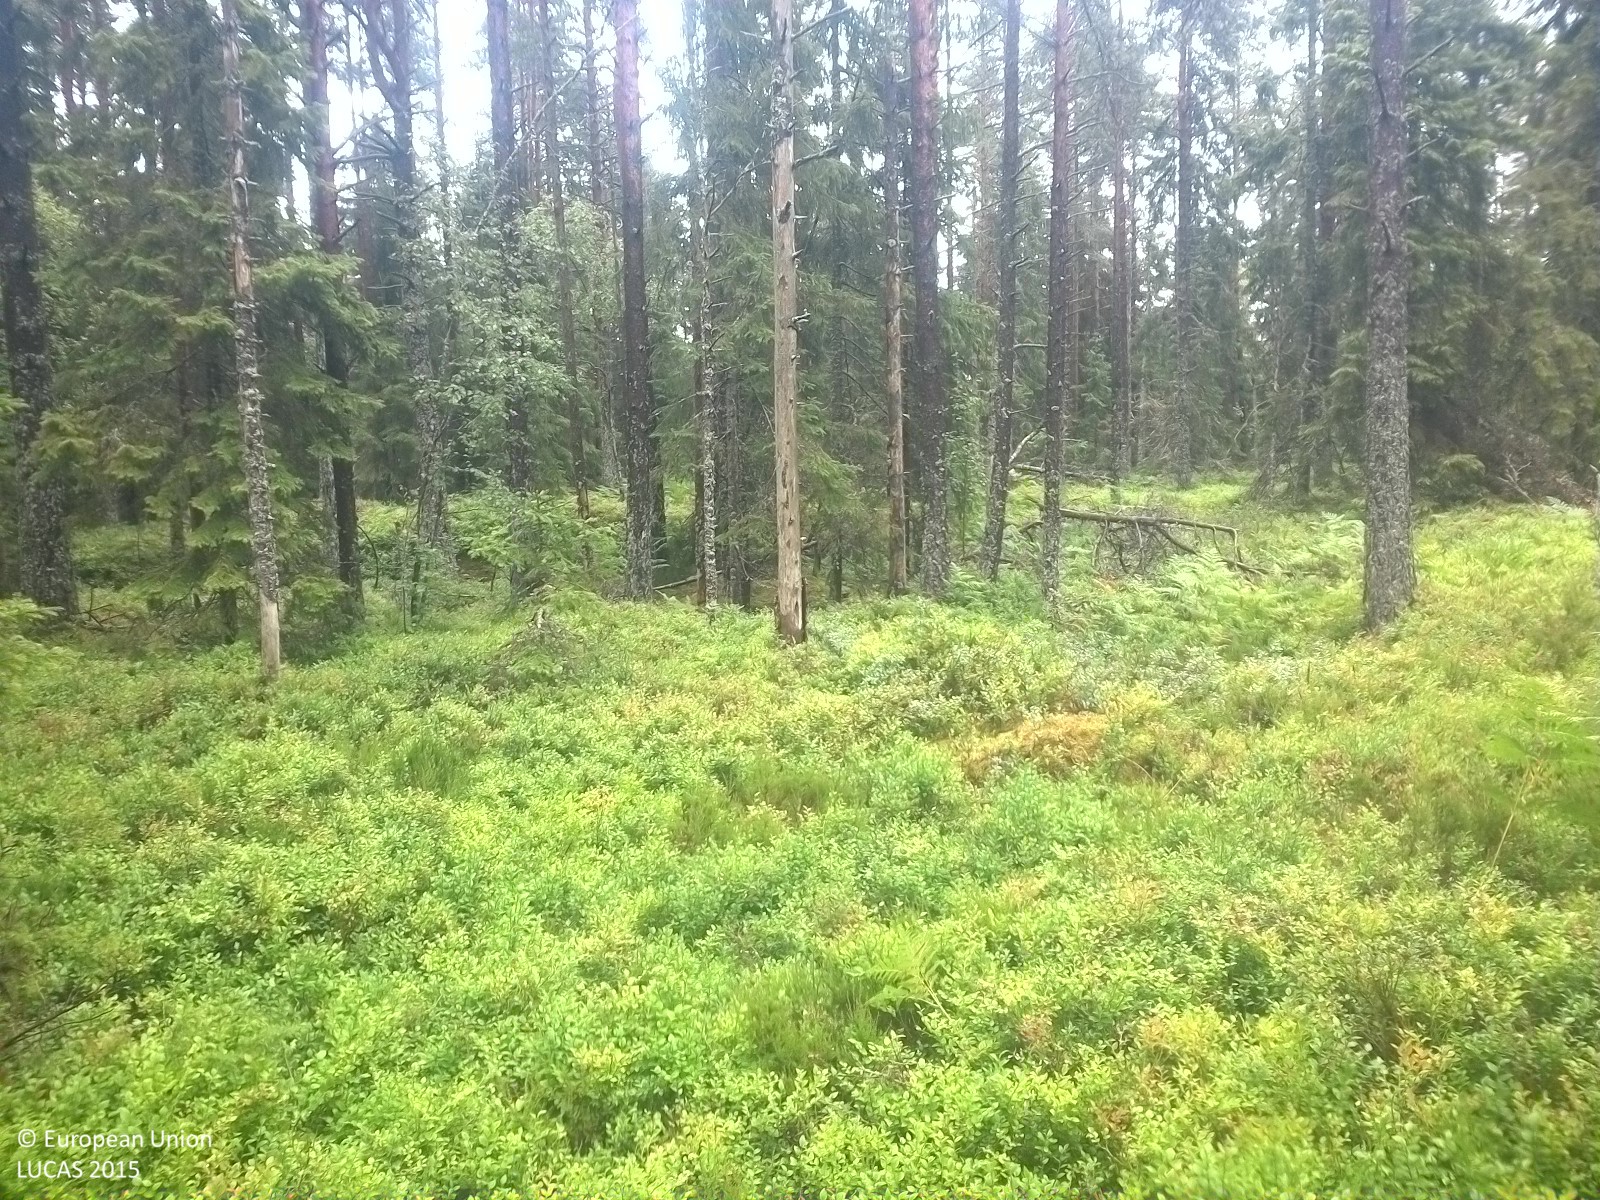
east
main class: Woodland
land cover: Pine dominated mixed woodland
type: boreal forest
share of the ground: 25 - 50 %
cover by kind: herbaceous plants 40 %, coniferous forest trees 25 %, shrubs 15 %, broadleaved forest trees 10 %, lichens and mosses 10 %
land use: Forestry
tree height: > 5 m
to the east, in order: Pine dominated mixed woodland; Other mixed woodland; Other coniferous woodland; Other mixed woodland; Pine dominated mixed woodland; Other mixed woodland; Pine dominated mixed woodland
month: July
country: SE
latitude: 58.8246
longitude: 15.1367
